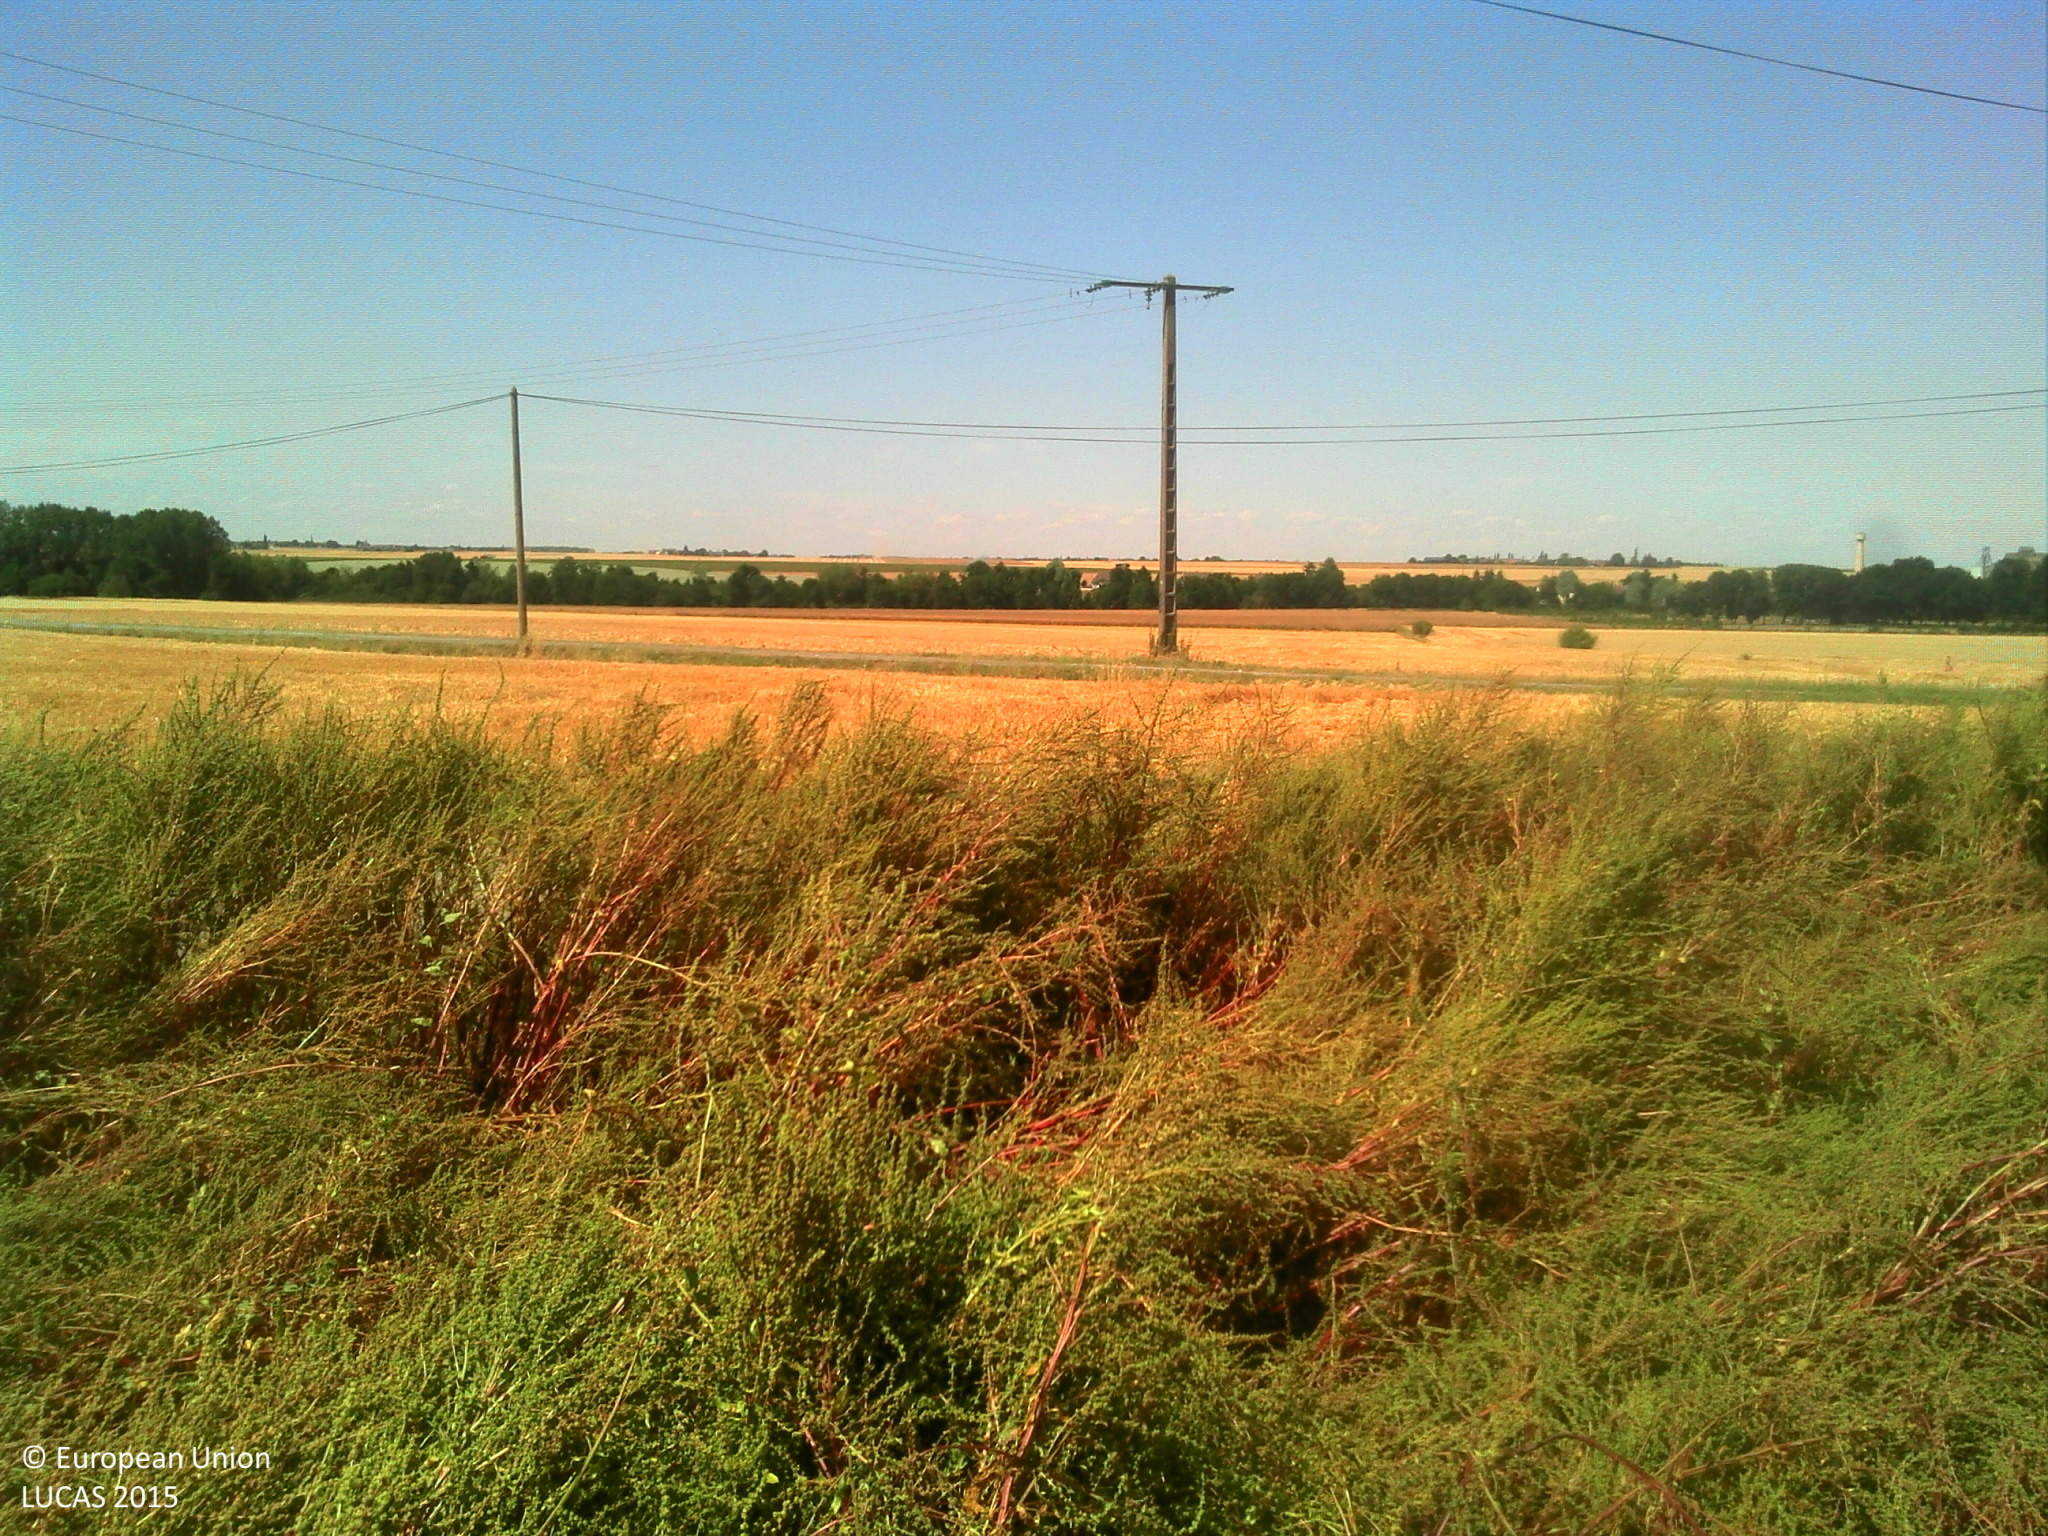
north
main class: Cropland
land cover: Sugar beet
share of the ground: > 75 %
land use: Agriculture (excluding fallow land and kitchen gardens)
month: July
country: FR
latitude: 48.2030
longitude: 1.2767
